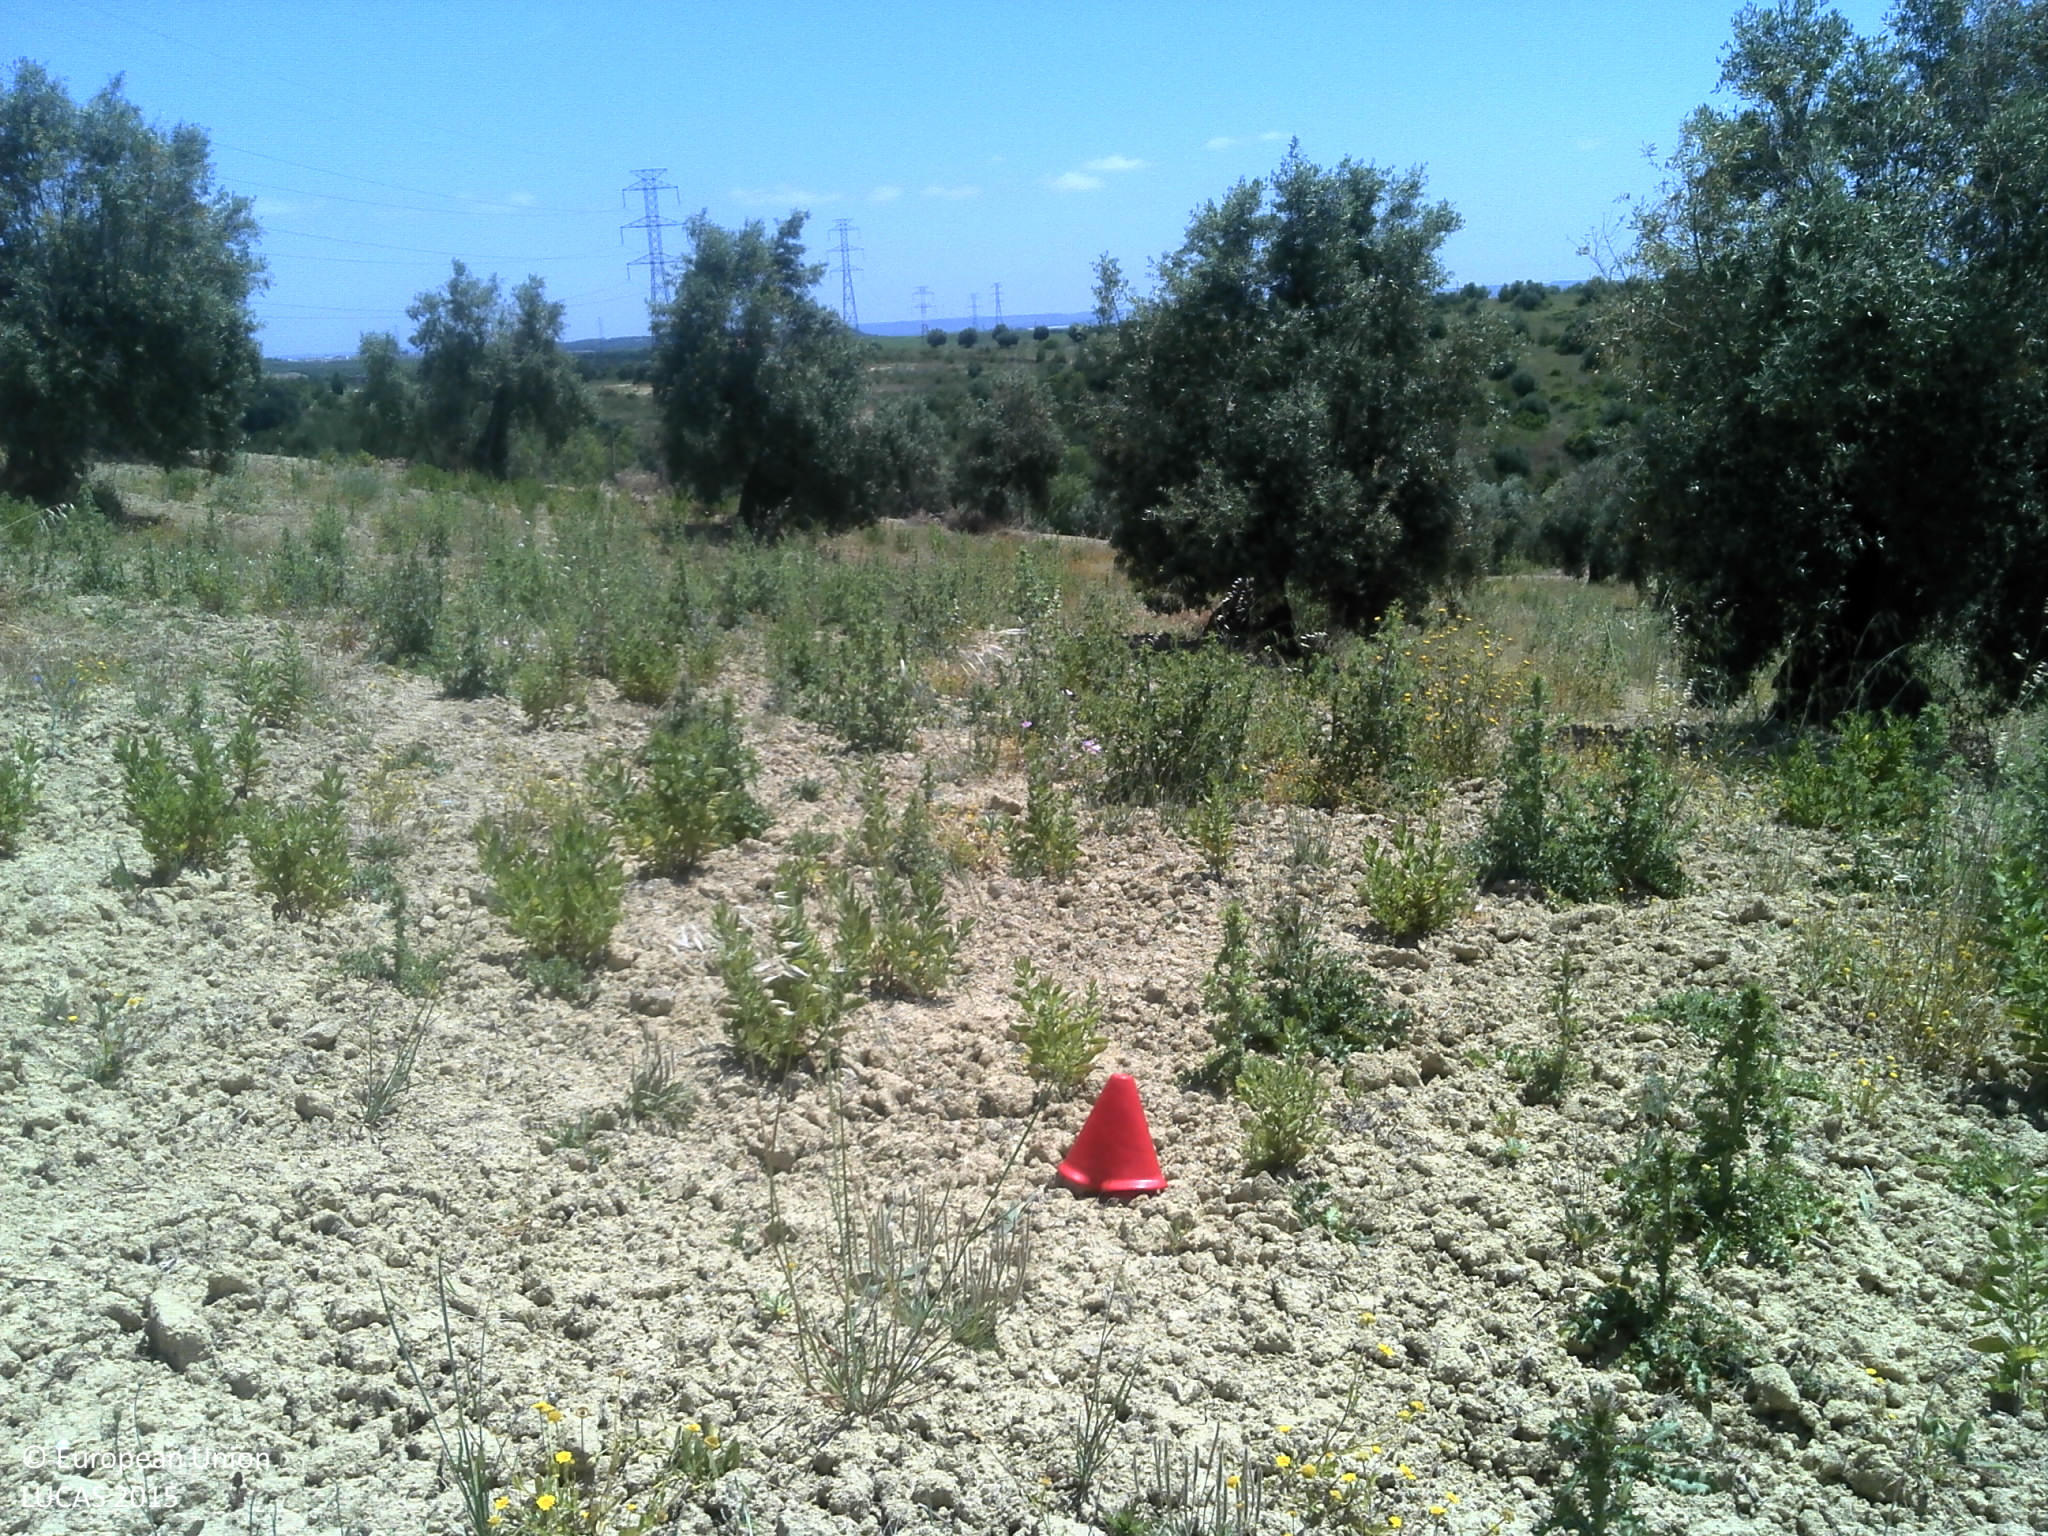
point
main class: Cropland
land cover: Olive groves
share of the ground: 25 - 50 %
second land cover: Spontaneously vegetated surfaces
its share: 10 - 25 %
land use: Agriculture (excluding fallow land and kitchen gardens)
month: June
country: PT
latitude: 39.2834
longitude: -8.7041
